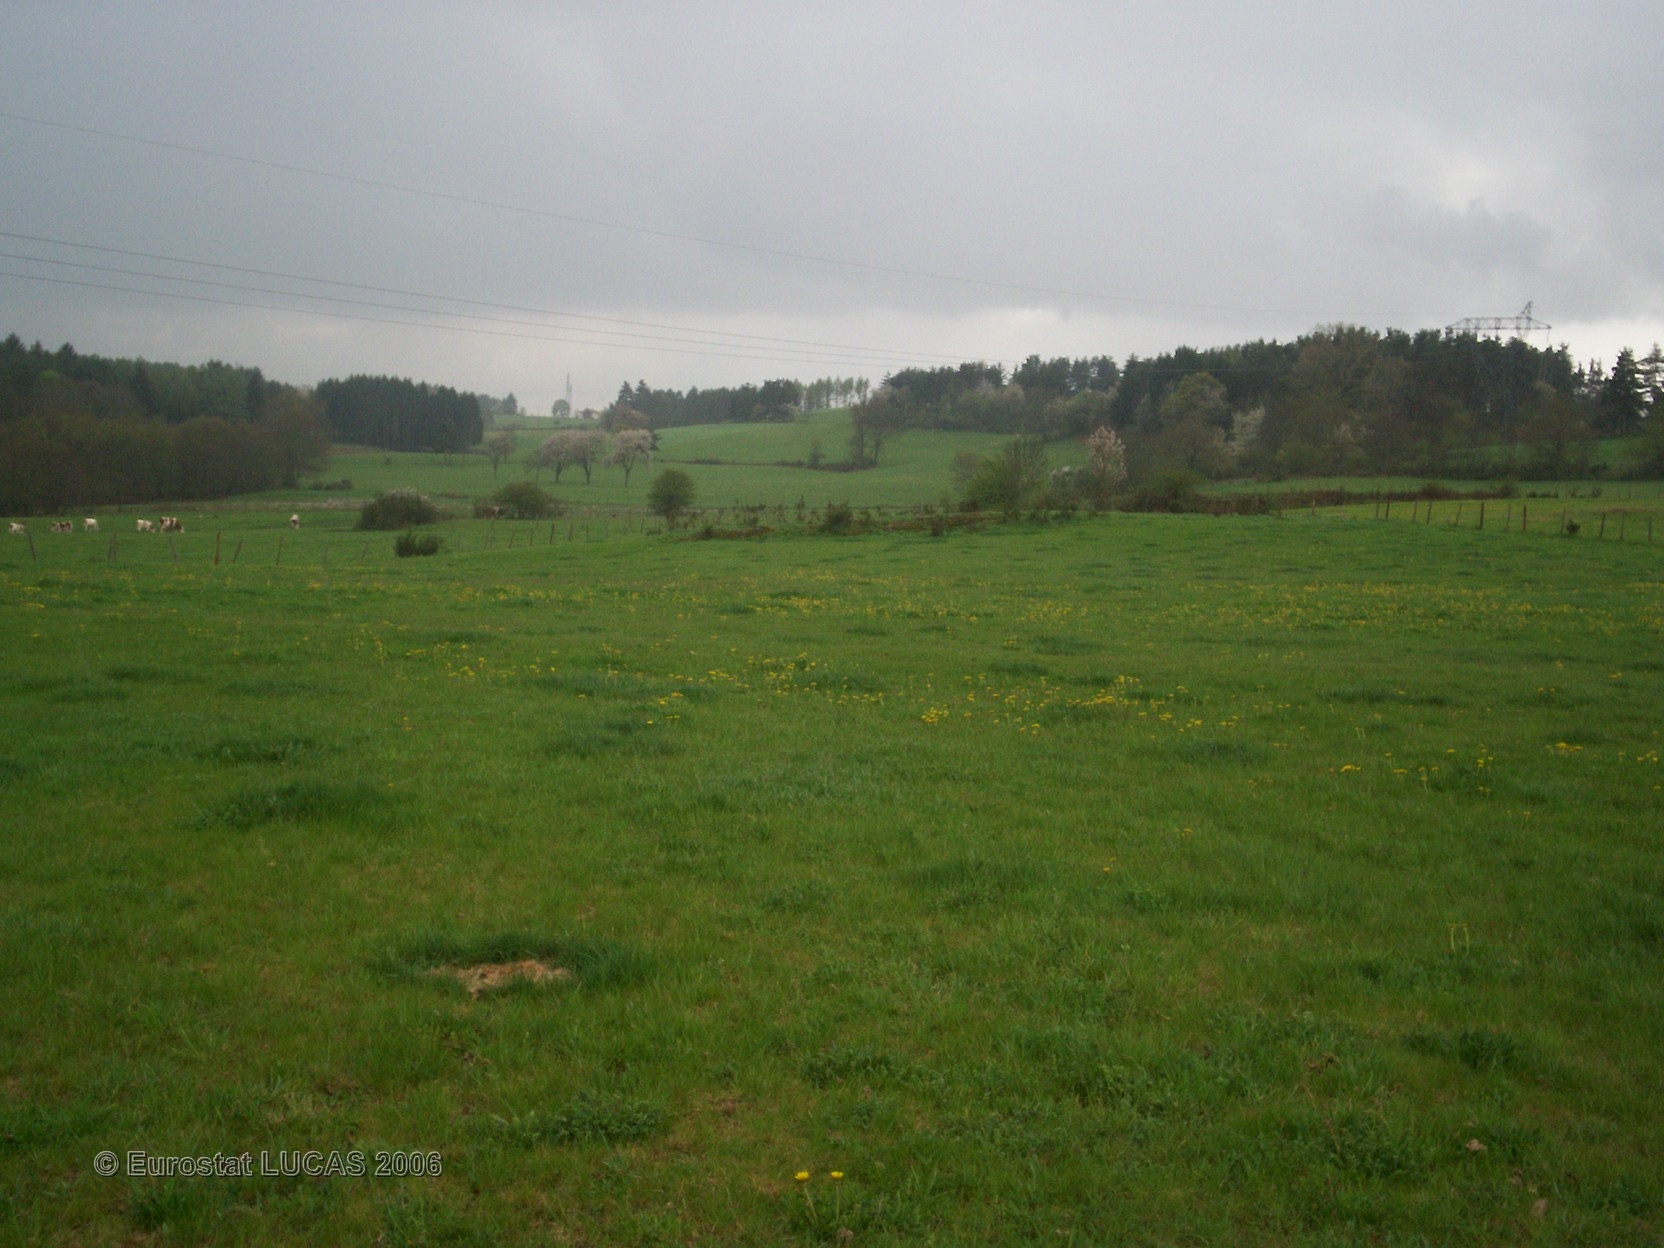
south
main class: Grassland
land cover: Grassland without tree/shrub cover
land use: Agriculture (excluding fallow land and kitchen gardens)
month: April
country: FR
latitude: 45.2536
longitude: 4.1808
